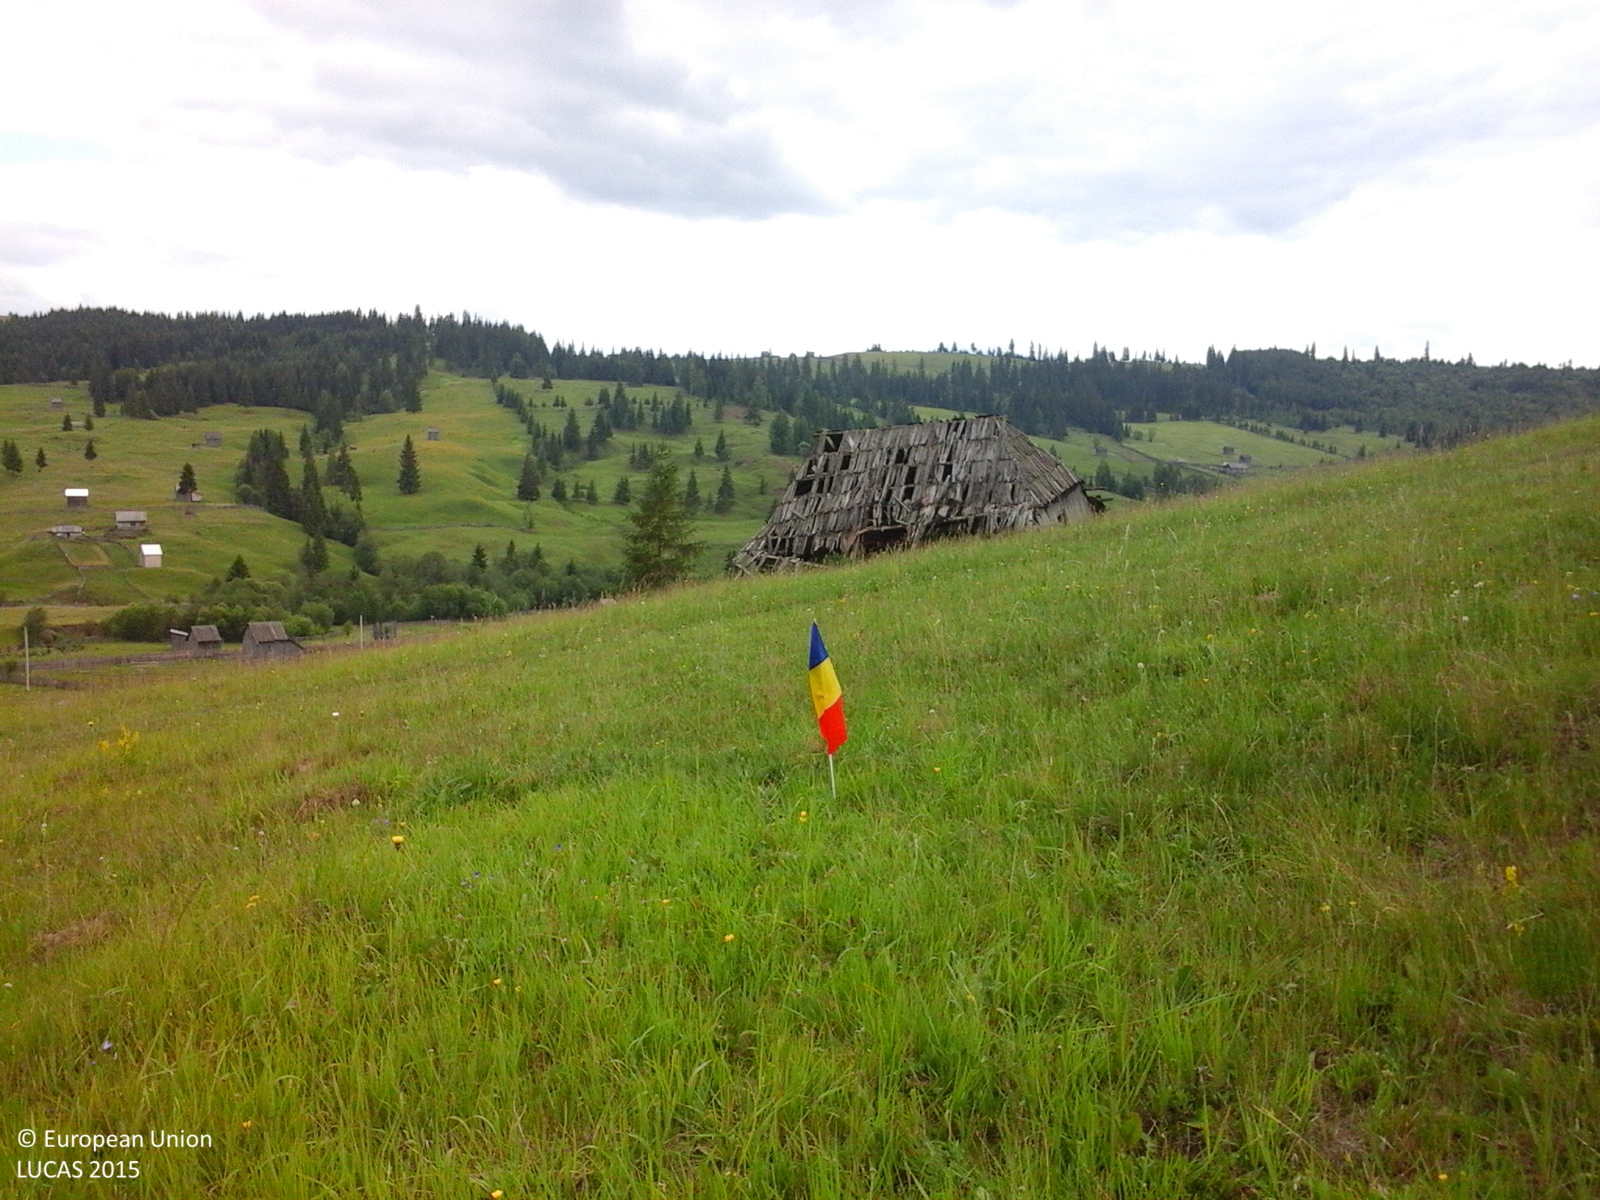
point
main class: Grassland
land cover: Grassland without tree/shrub cover
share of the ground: > 75 %
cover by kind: herbaceous plants 100 %
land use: Agriculture (excluding fallow land and kitchen gardens)
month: June
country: RO
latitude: 47.6130
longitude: 25.3732
